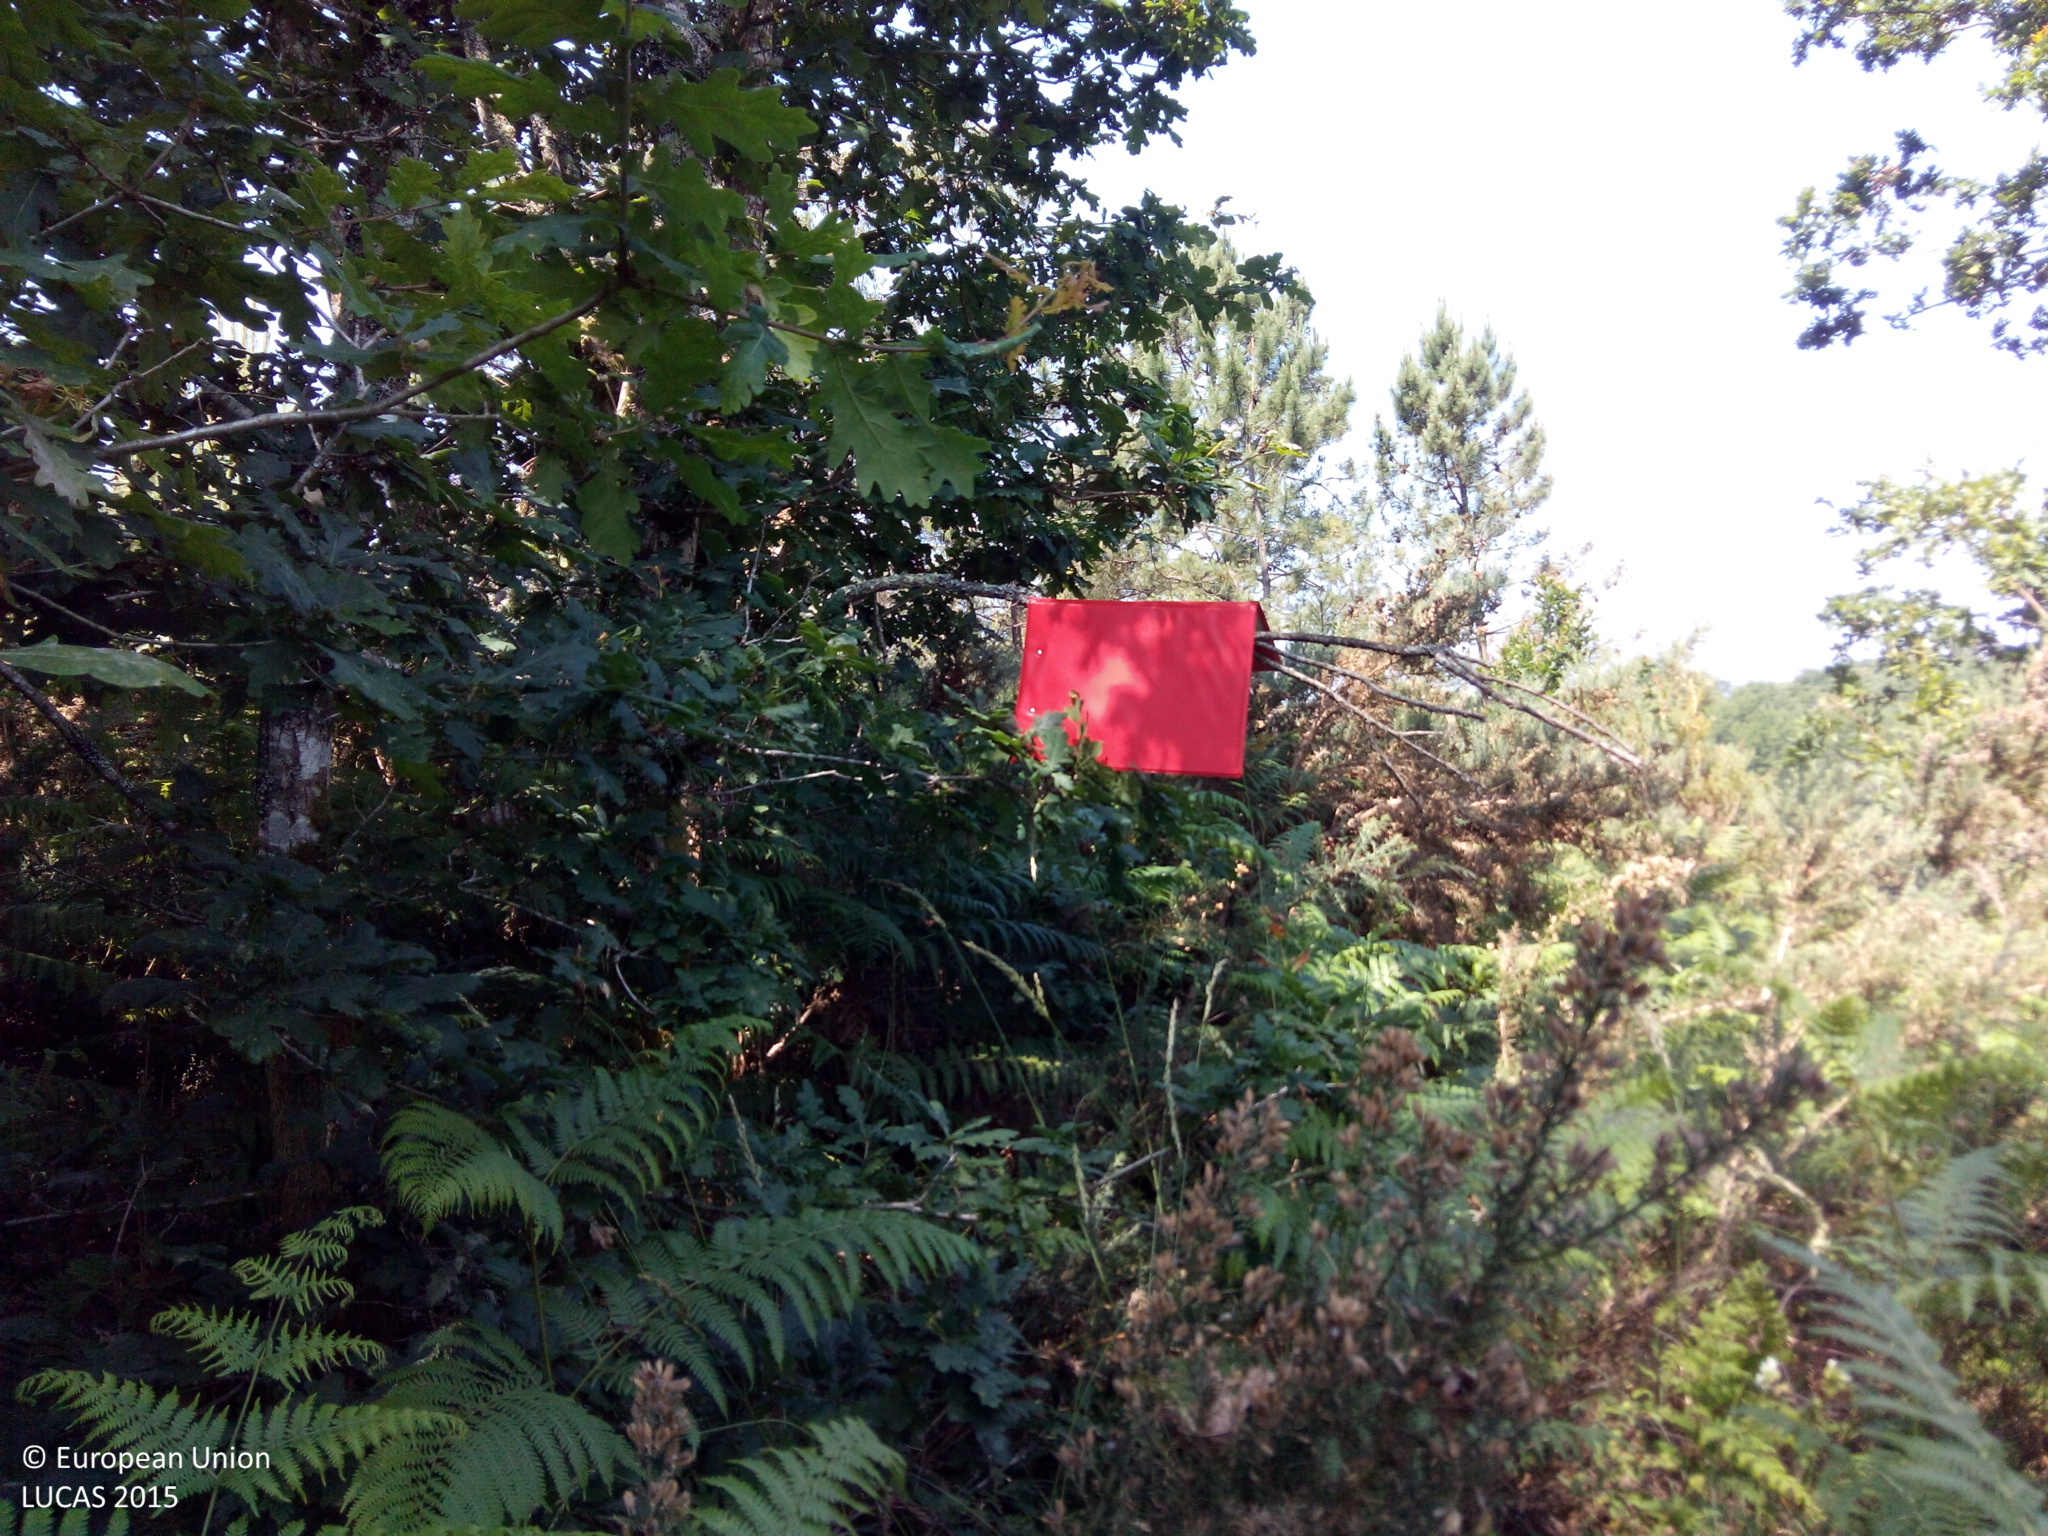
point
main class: Woodland
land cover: Broadleaved woodland
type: acidophilous oak and oak-birch forest
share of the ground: > 75 %
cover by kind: broadleaved forest trees 100 %
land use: Forestry
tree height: > 5 m
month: June
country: ES
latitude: 42.7454
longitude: -8.4869
